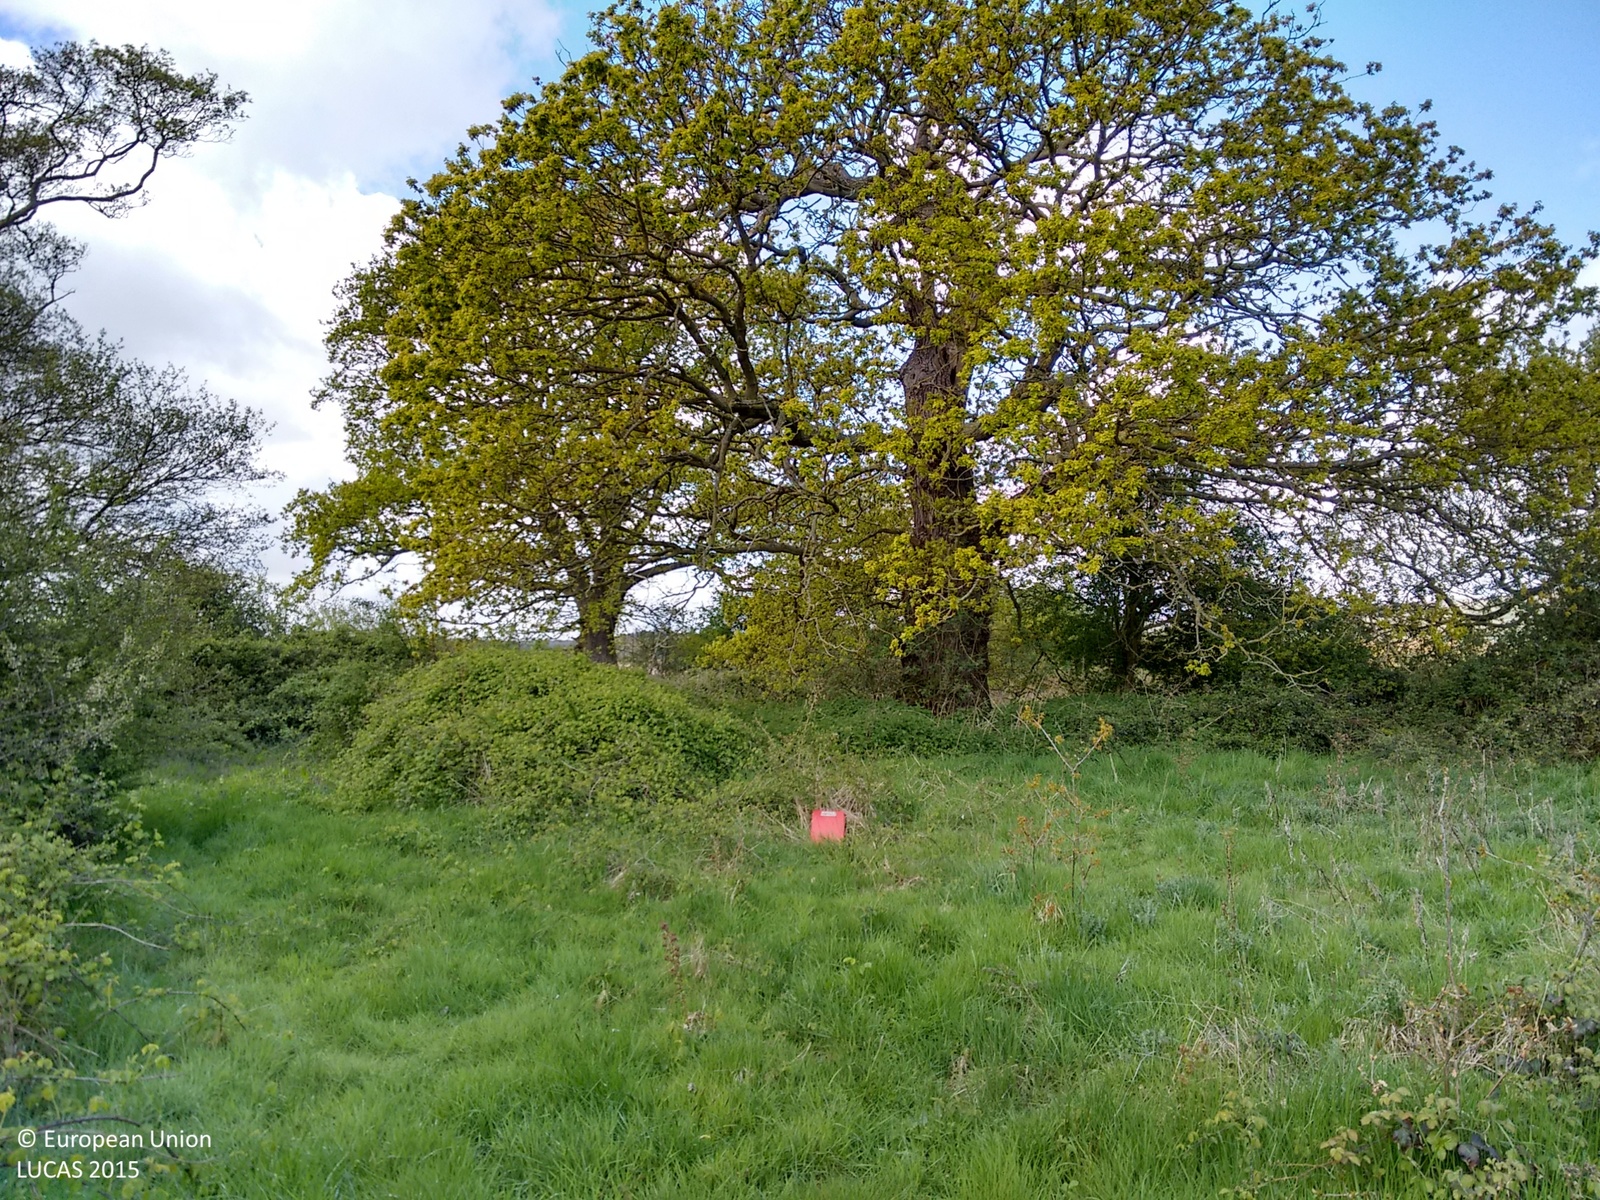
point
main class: Grassland
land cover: Grassland with sparse tree/shrub cover
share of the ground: > 75 %
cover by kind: herbaceous plants 85 %, shrubs 10 %, broadleaved forest trees 5 %
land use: Abandoned areas
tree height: < 5 m
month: April
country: GB
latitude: 51.3177
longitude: 0.4010
